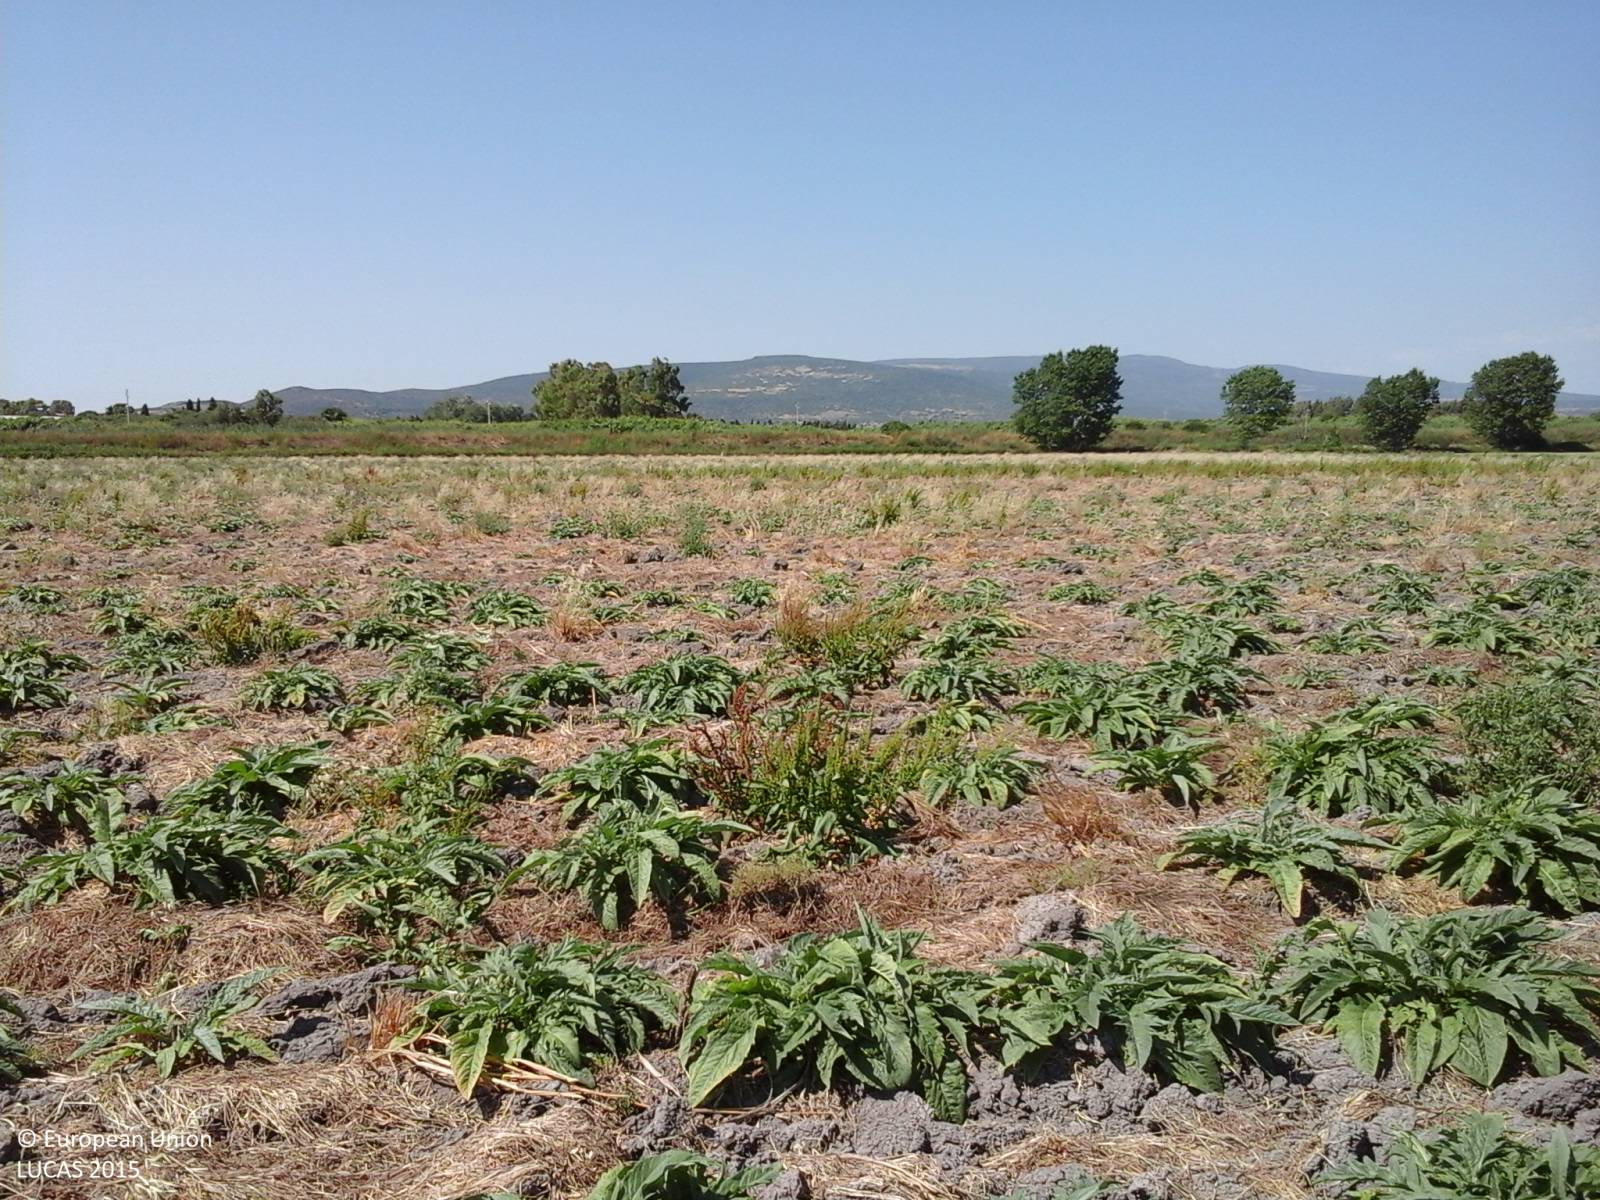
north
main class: Cropland
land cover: Other fresh vegetables
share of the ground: 50 - 75 %
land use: Agriculture (excluding fallow land and kitchen gardens)
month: July
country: IT
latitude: 40.0030
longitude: 8.5437
